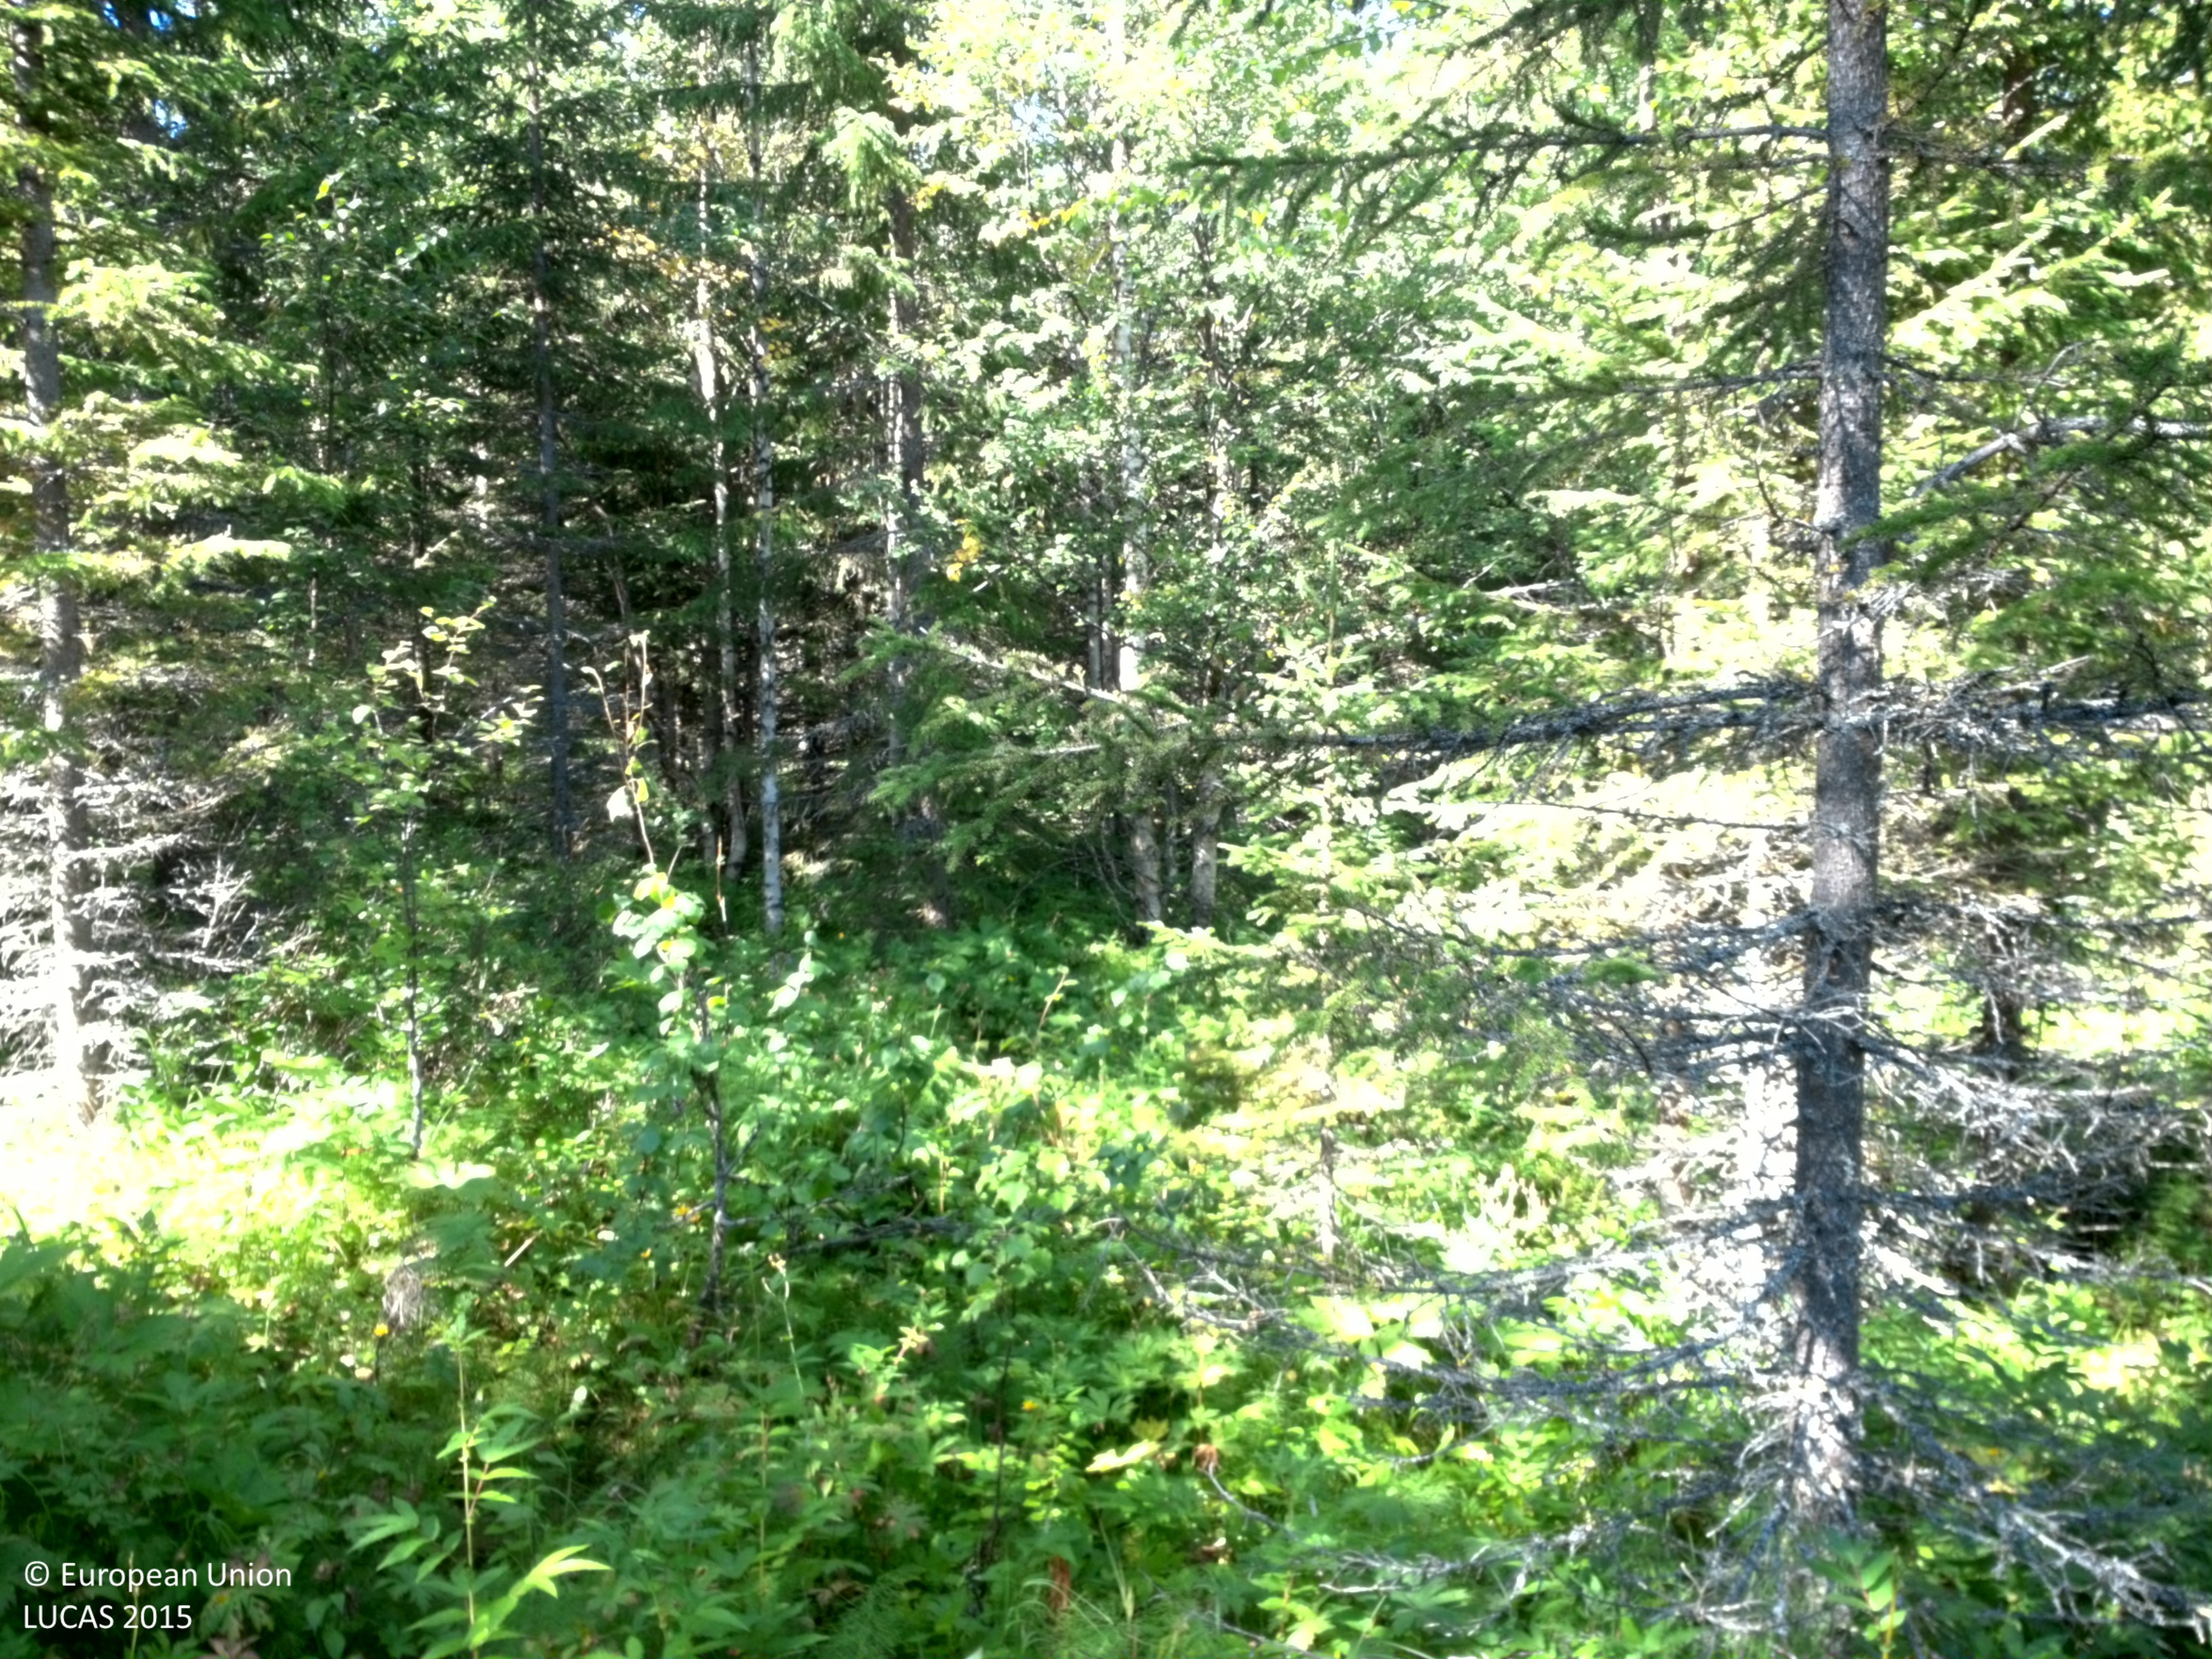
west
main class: Woodland
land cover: Spruce dominated mixed woodland
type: boreal forest
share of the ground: 25 - 50 %
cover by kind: herbaceous plants 50 %, coniferous forest trees 25 %, broadleaved forest trees 20 %, shrubs 5 %
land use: Forestry
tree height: > 5 m
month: August
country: SE
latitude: 64.7331
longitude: 16.1194
